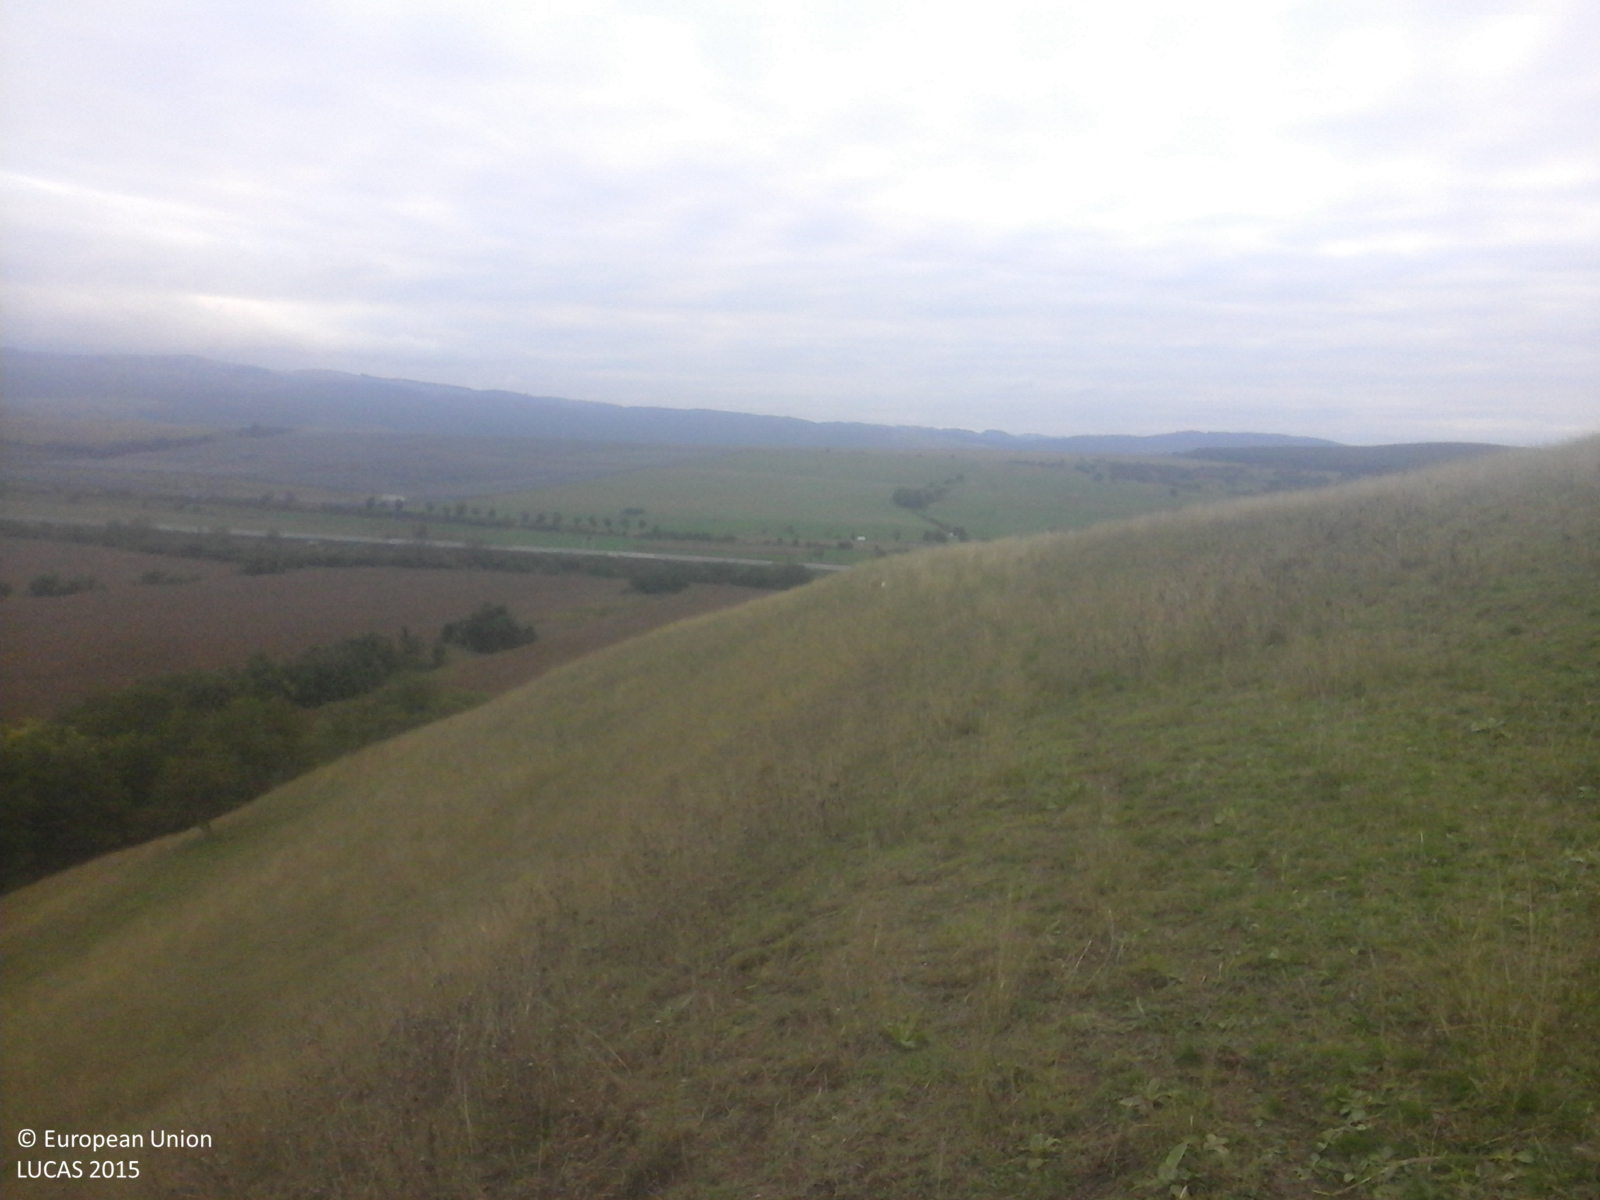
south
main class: Grassland
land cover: Grassland without tree/shrub cover
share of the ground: > 75 %
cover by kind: herbaceous plants 100 %
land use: Agriculture (excluding fallow land and kitchen gardens)
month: September
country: RO
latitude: 45.9150
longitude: 23.7474
